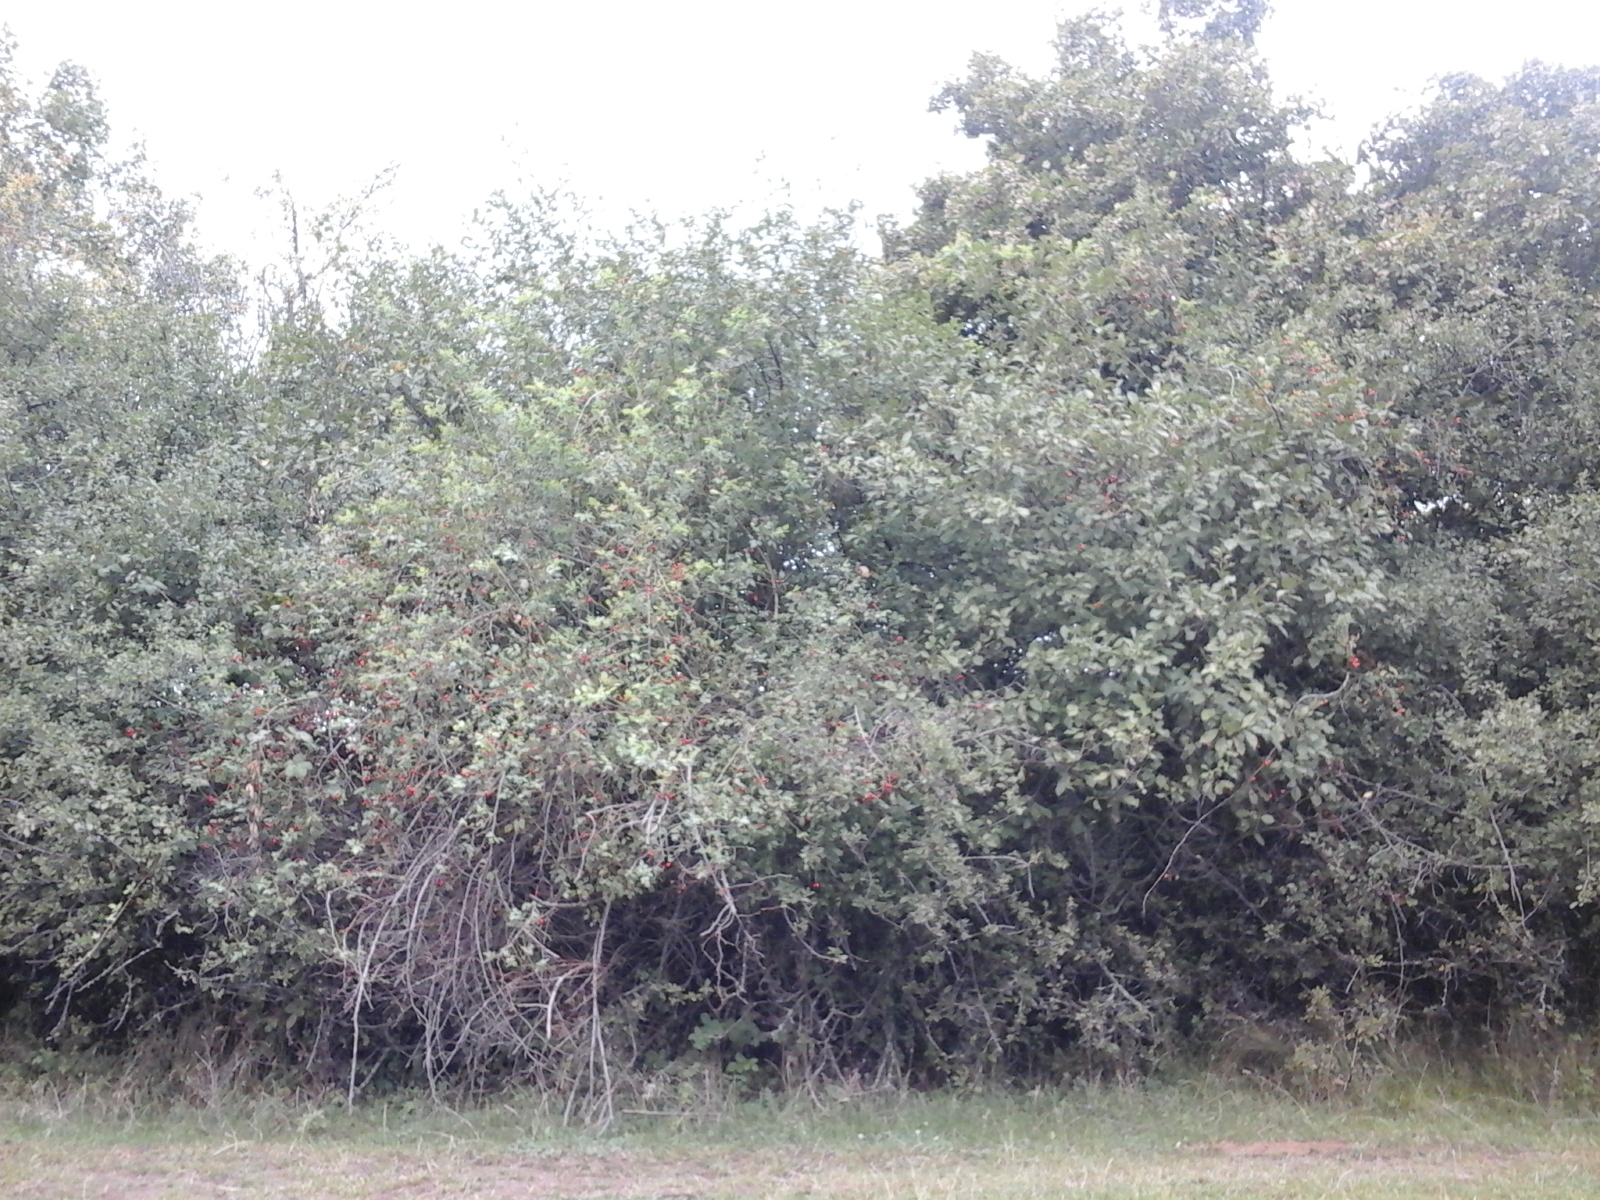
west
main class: Grassland
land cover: Grassland with sparse tree/shrub cover
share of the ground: > 75 %
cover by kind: herbaceous plants 85 %, shrubs 10 %, broadleaved forest trees 5 %
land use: Agriculture (excluding fallow land and kitchen gardens)
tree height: < 5 m
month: September
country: RO
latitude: 47.3259
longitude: 22.5071
